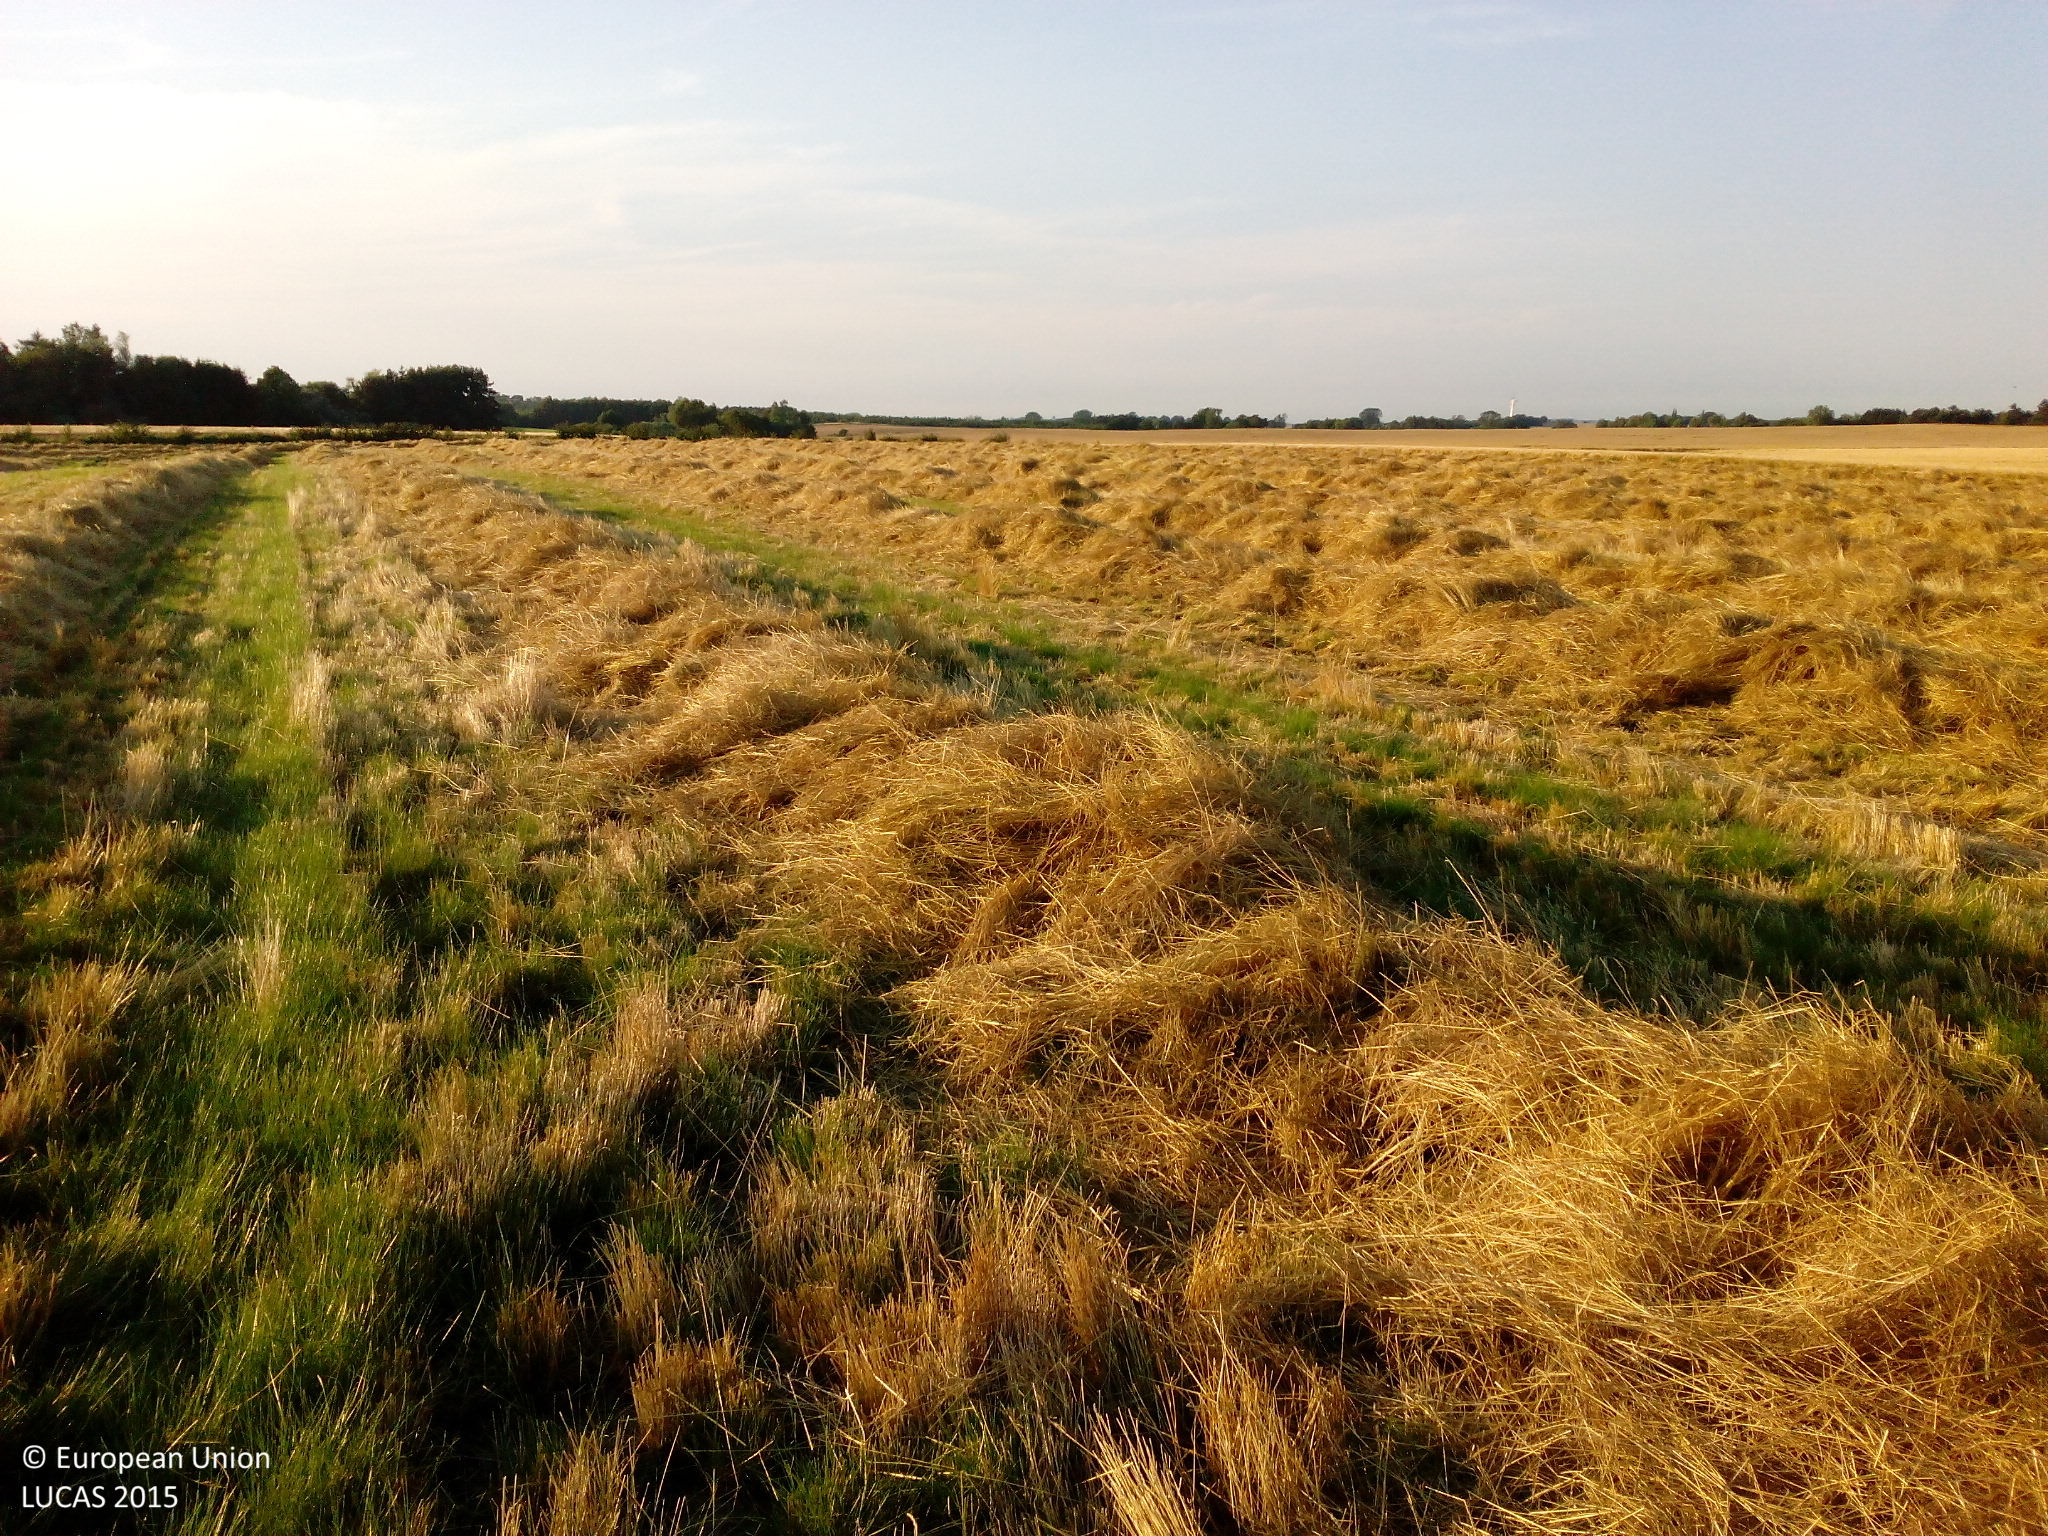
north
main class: Cropland
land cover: Temporary grasslands
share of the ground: > 75 %
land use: Agriculture (excluding fallow land and kitchen gardens)
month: August
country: DK
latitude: 55.6524
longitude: 11.8895
